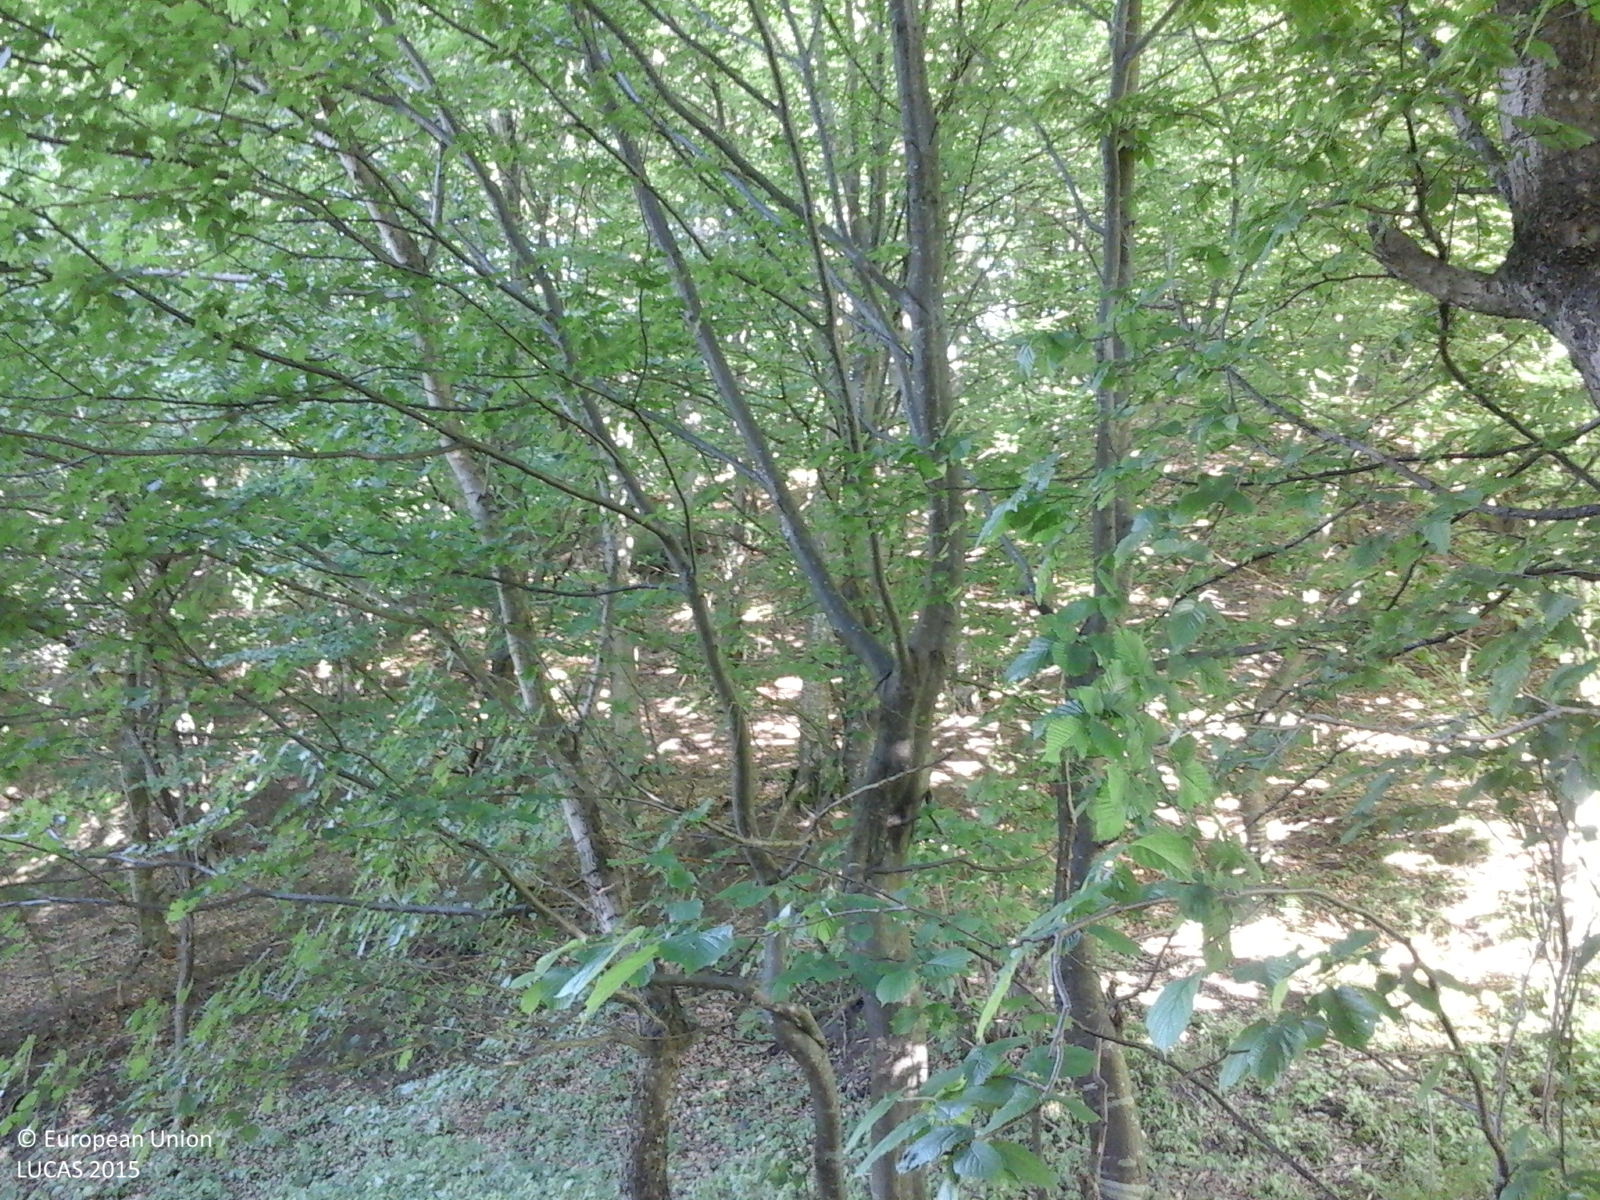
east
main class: Woodland
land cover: Broadleaved woodland
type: beech forest
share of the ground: > 75 %
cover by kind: broadleaved forest trees 100 %
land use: Forestry
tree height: > 5 m
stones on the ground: < 10 %
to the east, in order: Broadleaved woodland; Grassland without tree/shrub cover
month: May
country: RO
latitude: 45.3079
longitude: 26.1992
